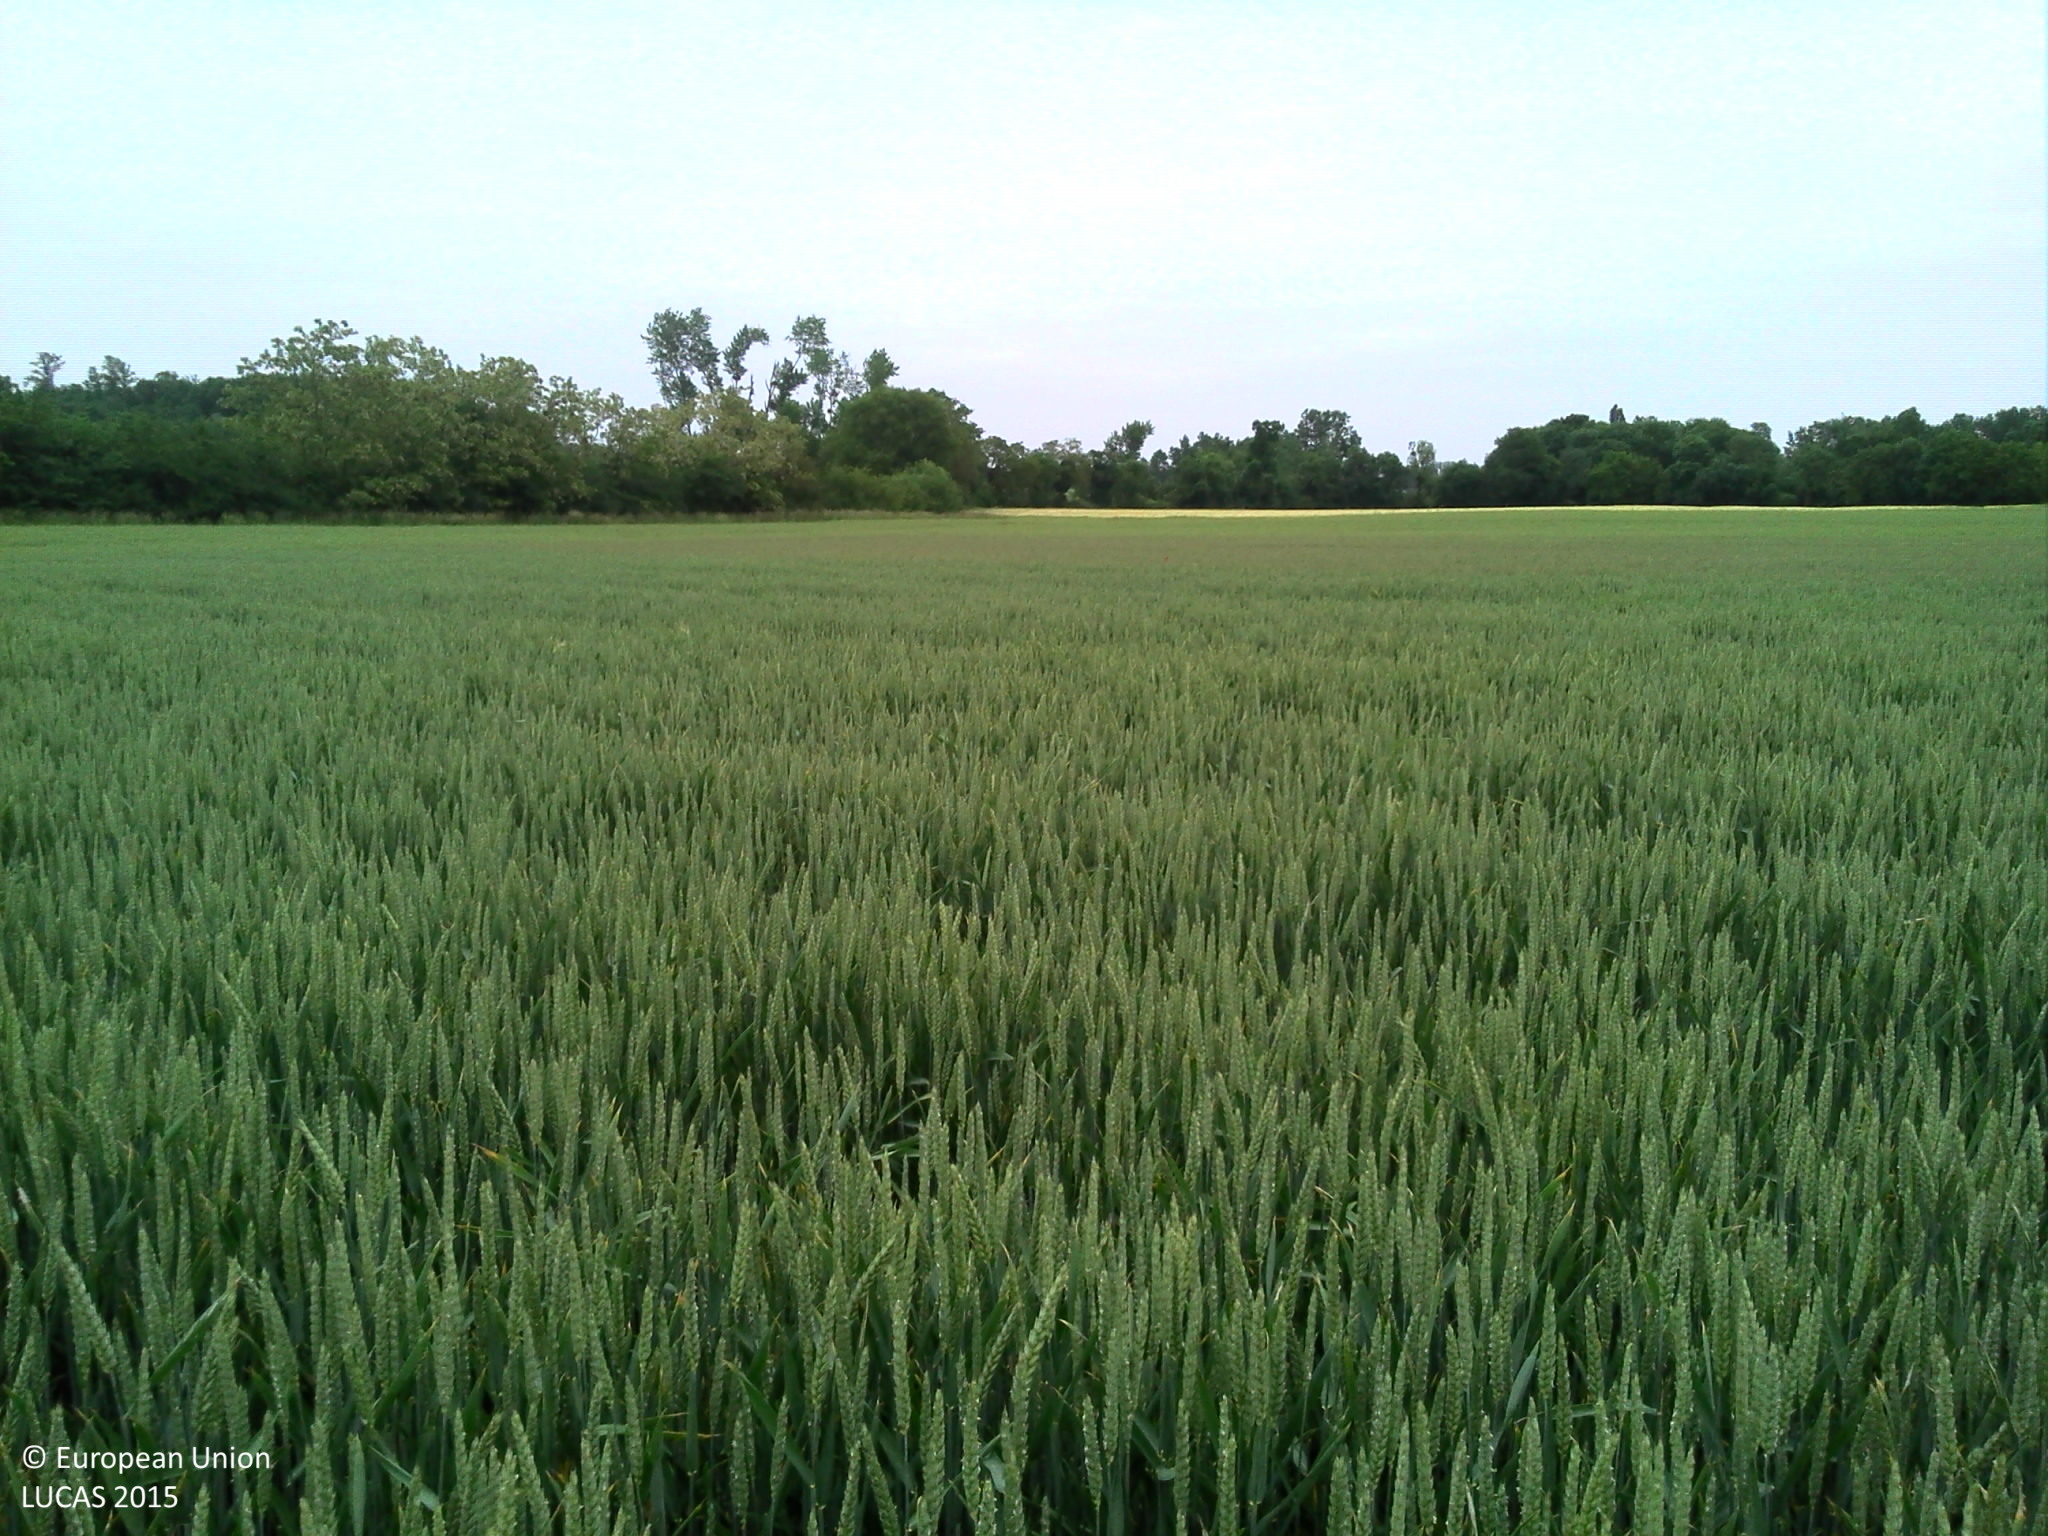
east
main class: Cropland
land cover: Common wheat
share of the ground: > 75 %
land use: Agriculture (excluding fallow land and kitchen gardens)
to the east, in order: Common wheat; Grassland without tree/shrub cover; Abandoned hedges; Ditches and canals; Abandoned hedges; Fences; Grassland without tree/shrub cover
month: May
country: FR
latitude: 46.7371
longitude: 0.2293
